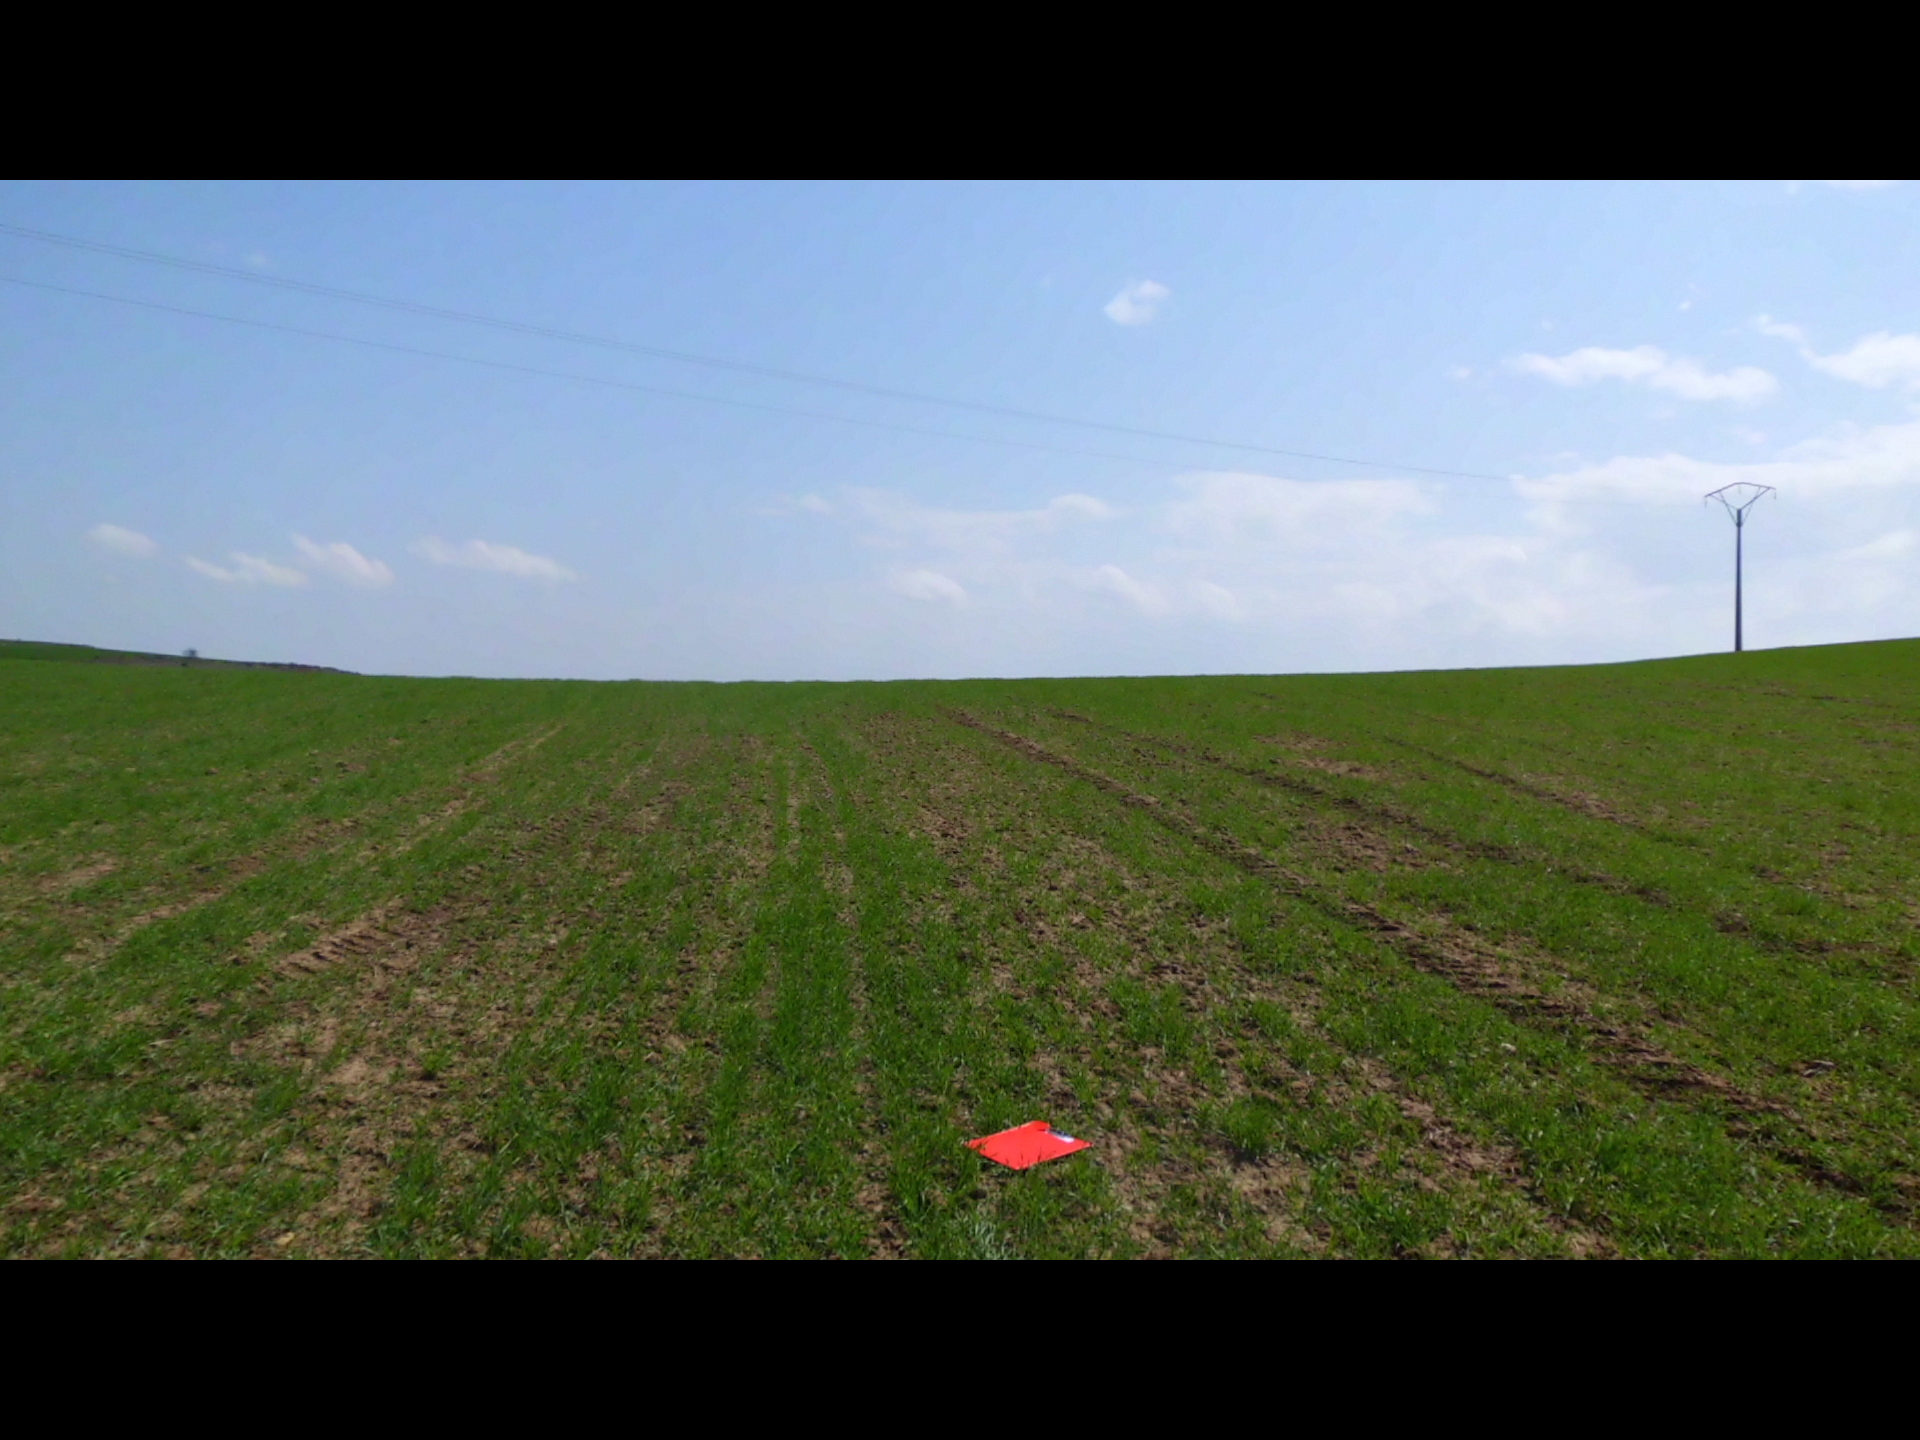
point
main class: Cropland
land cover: Barley
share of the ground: > 75 %
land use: Agriculture (excluding fallow land and kitchen gardens)
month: April
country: ES
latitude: 42.5218
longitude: -3.7083
